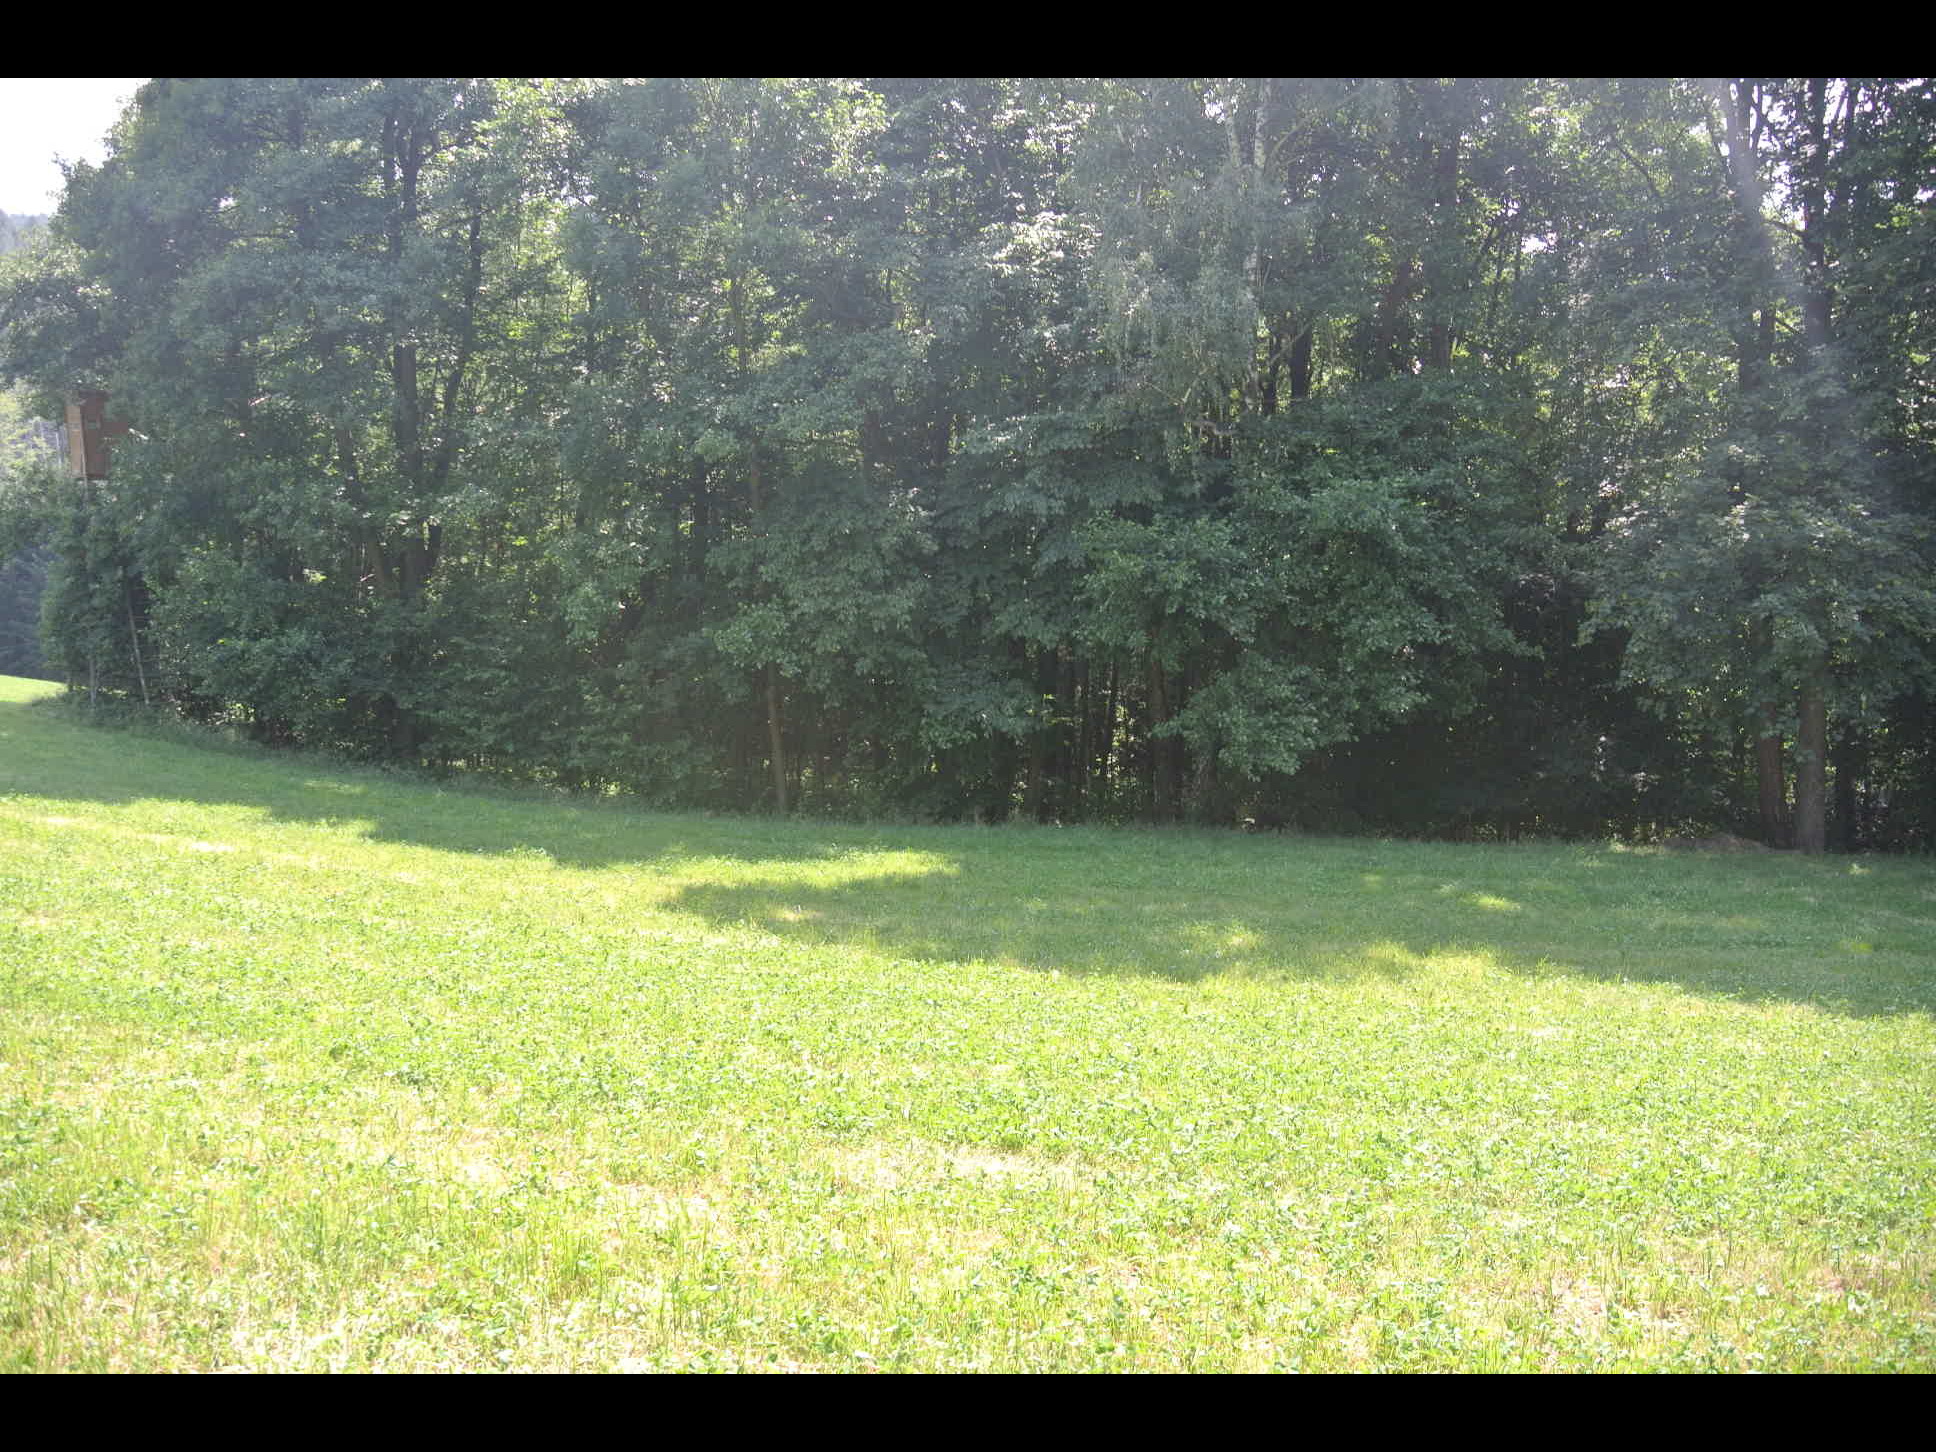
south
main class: Grassland
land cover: Grassland without tree/shrub cover
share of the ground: > 75 %
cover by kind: herbaceous plants 100 %
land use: Agriculture (excluding fallow land and kitchen gardens)
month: July
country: AT
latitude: 47.6179
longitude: 16.1632
